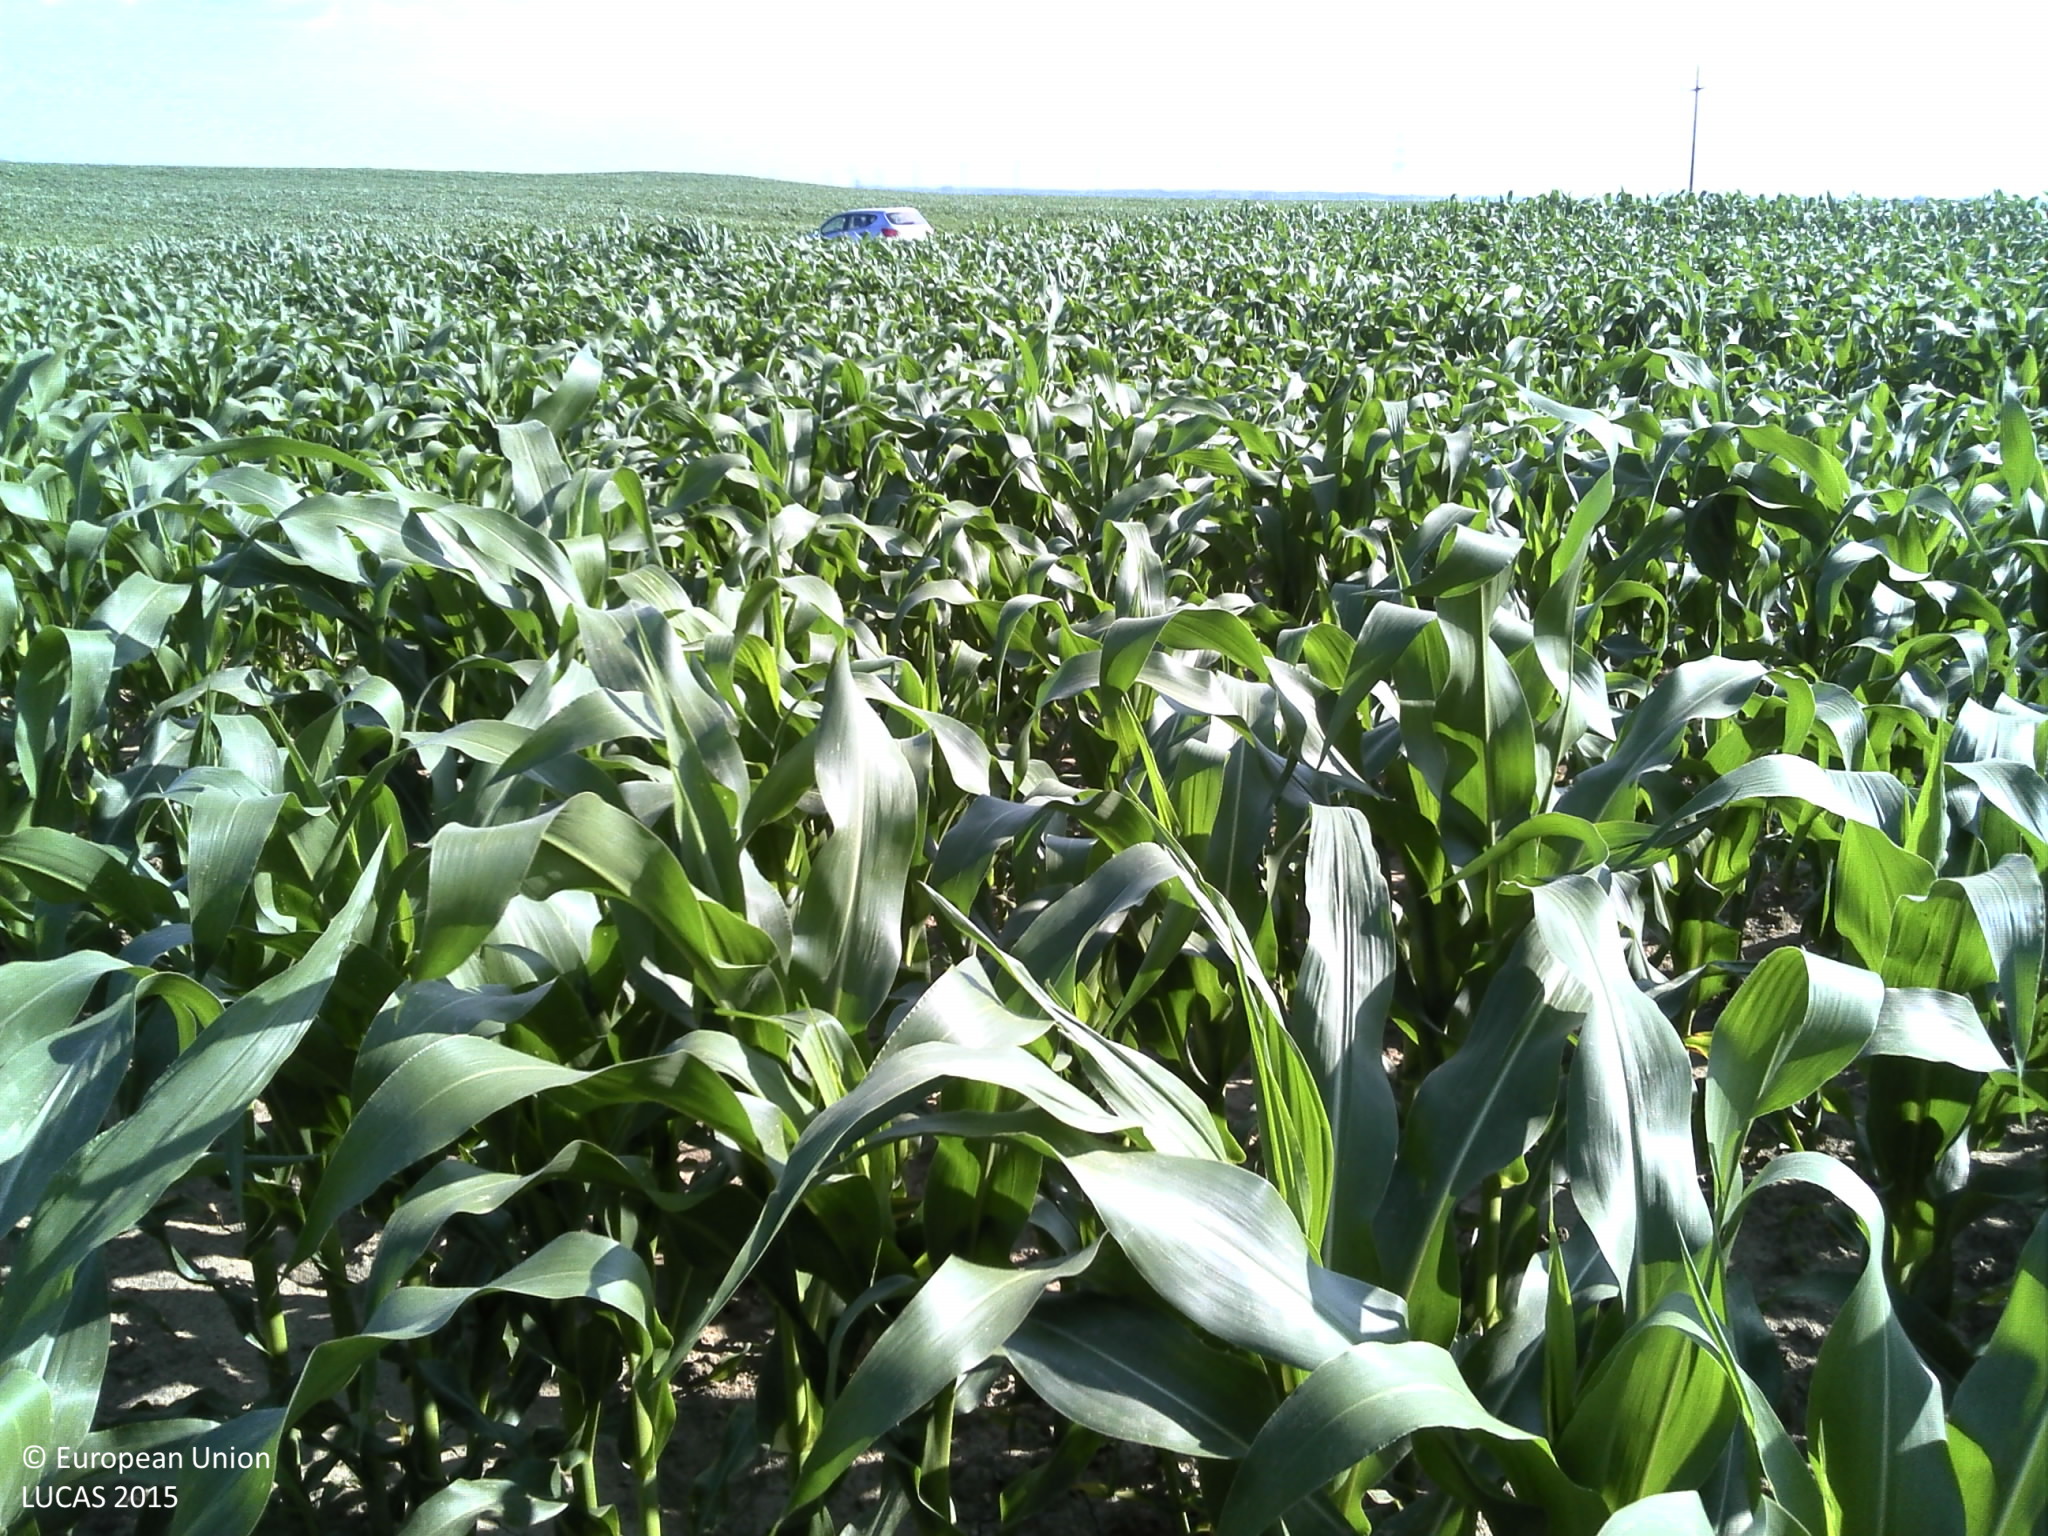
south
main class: Cropland
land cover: Maize
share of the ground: > 75 %
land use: Agriculture (excluding fallow land and kitchen gardens)
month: June
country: HR
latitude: 45.7364
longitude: 18.5539
